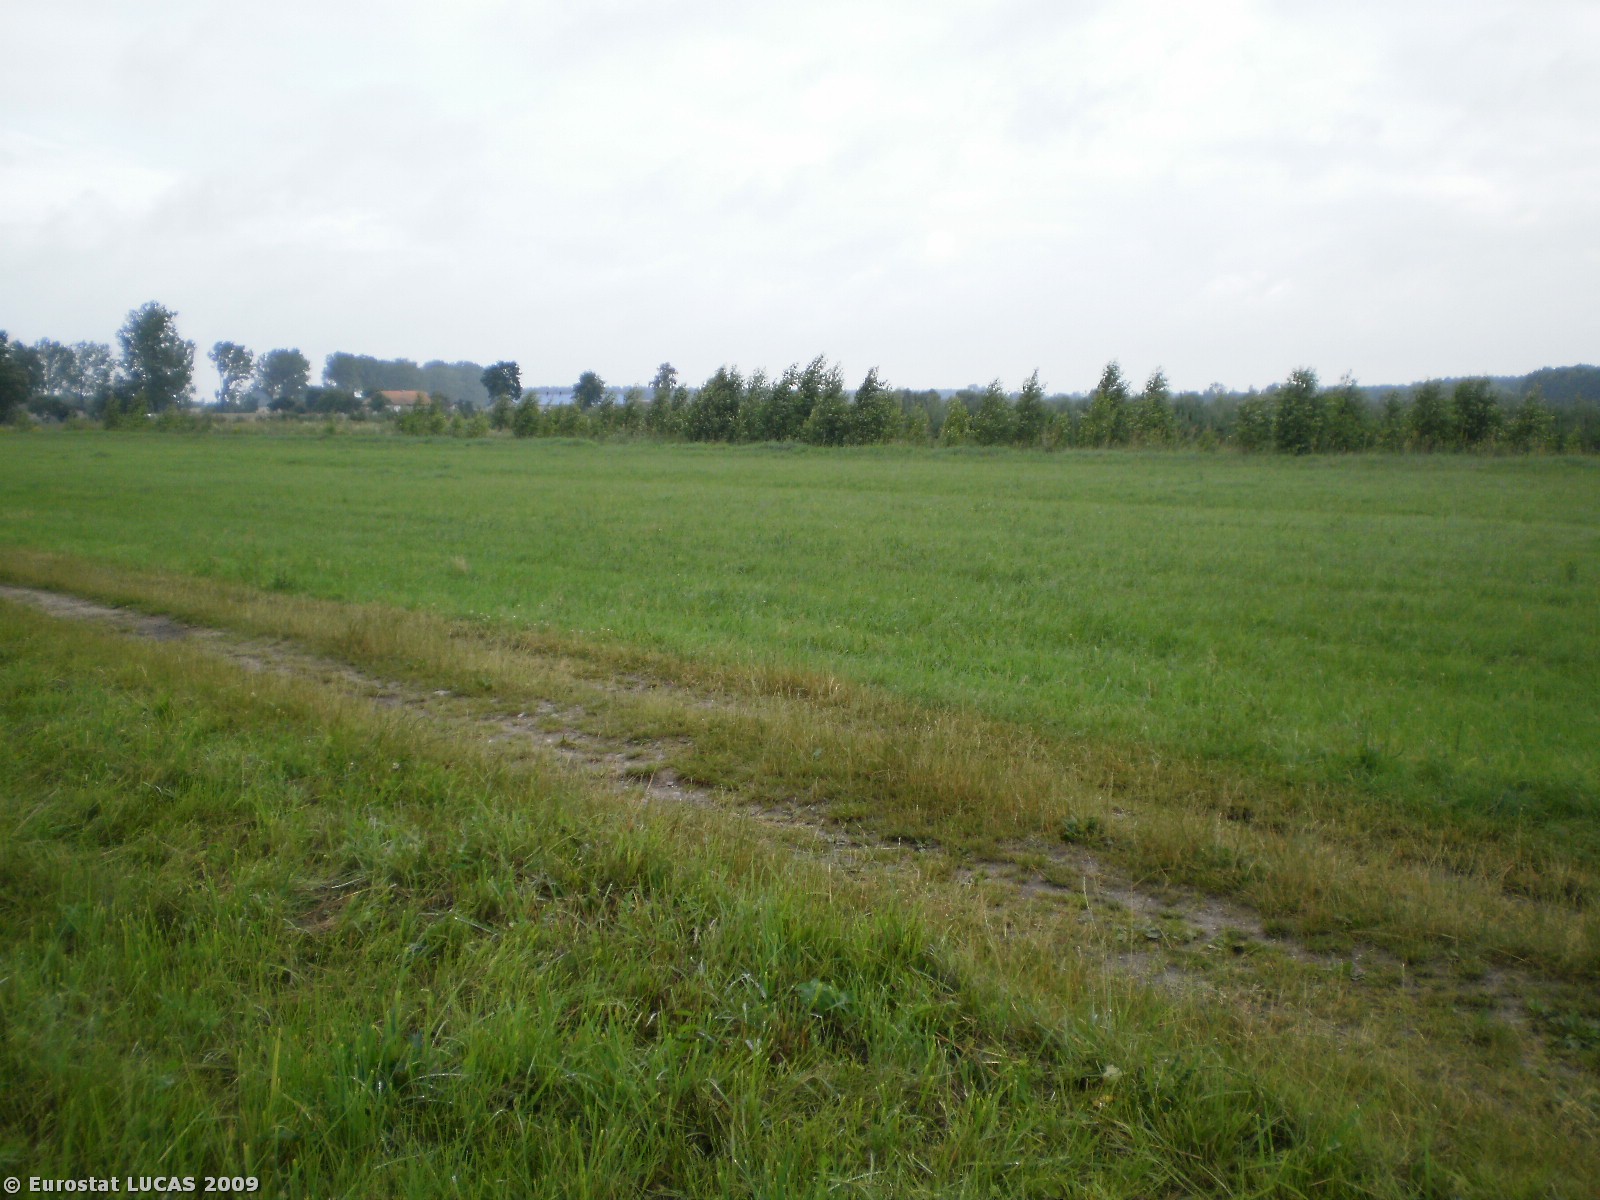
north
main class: Grassland
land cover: Grassland without tree/shrub cover
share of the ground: > 75 %
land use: Agriculture (excluding fallow land and kitchen gardens)
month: July
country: PL
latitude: 53.0940
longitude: 20.4454
